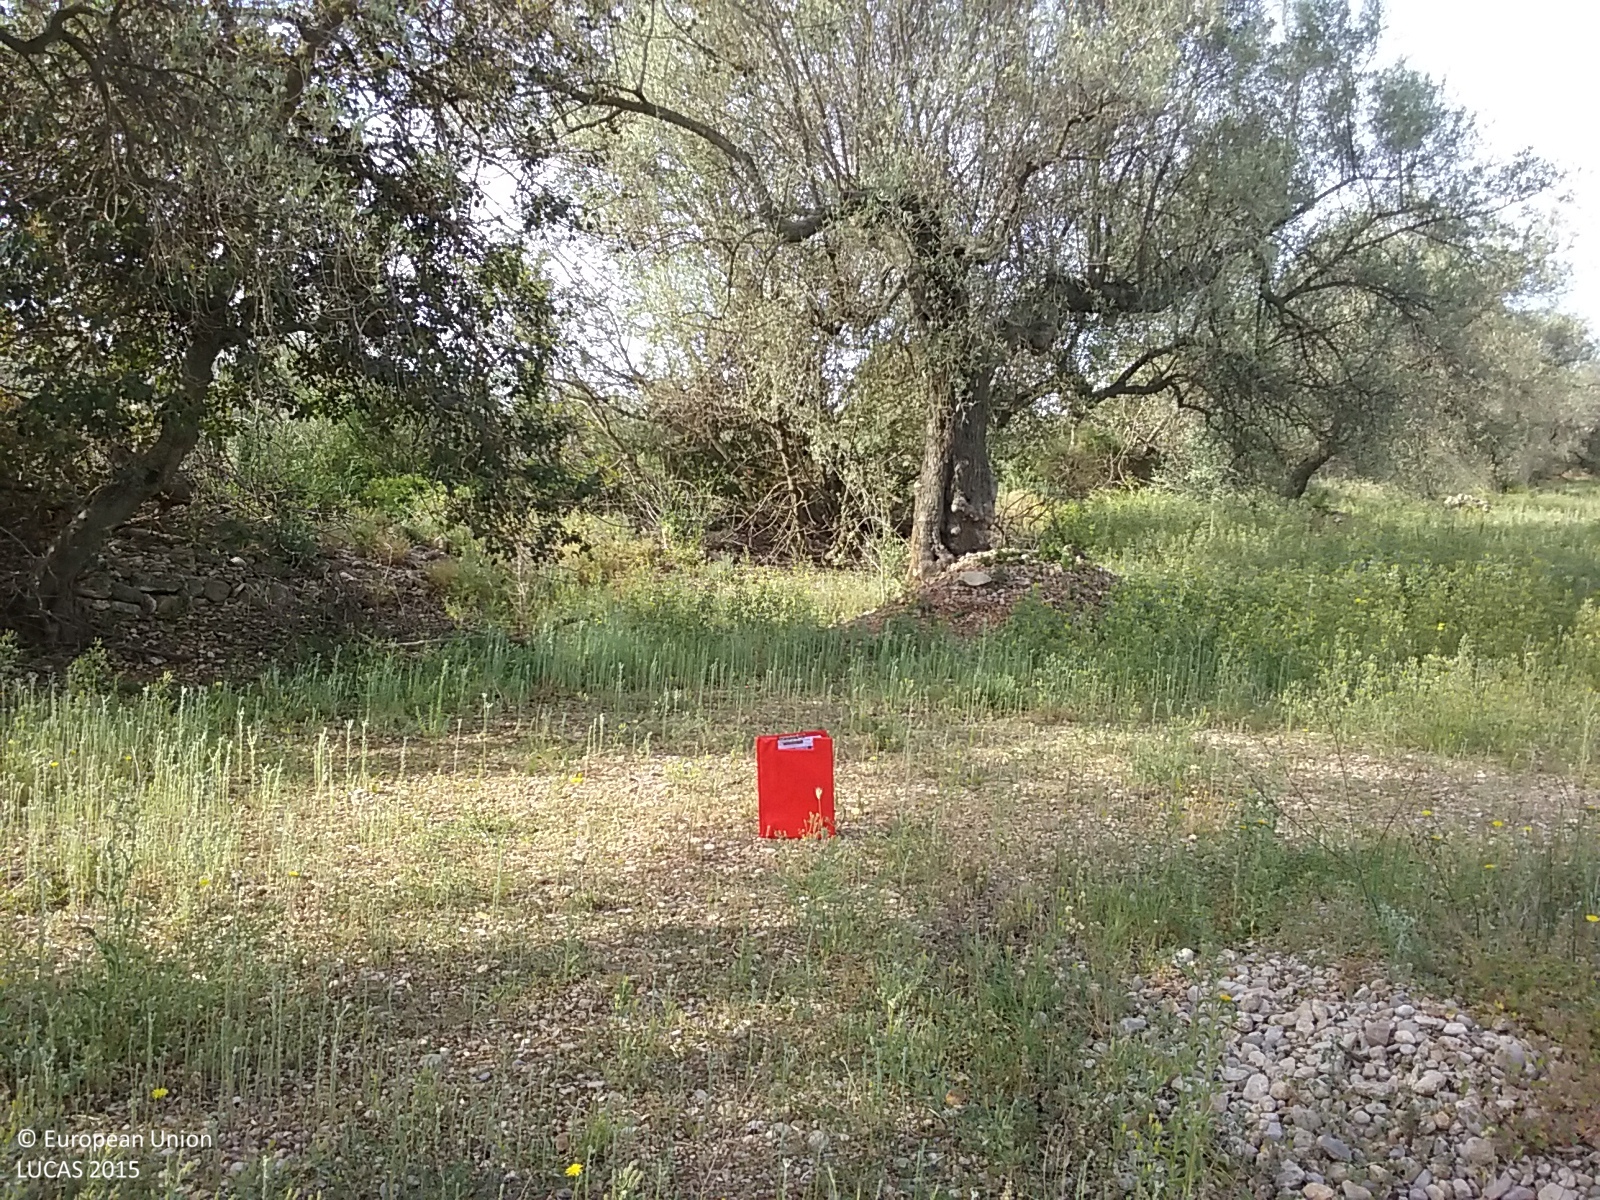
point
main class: Cropland
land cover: Olive groves
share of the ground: 25 - 50 %
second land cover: Grassland without tree/shrub cover
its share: > 75 %
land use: Agriculture (excluding fallow land and kitchen gardens)
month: May
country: ES
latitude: 40.6065
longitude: 0.3154
